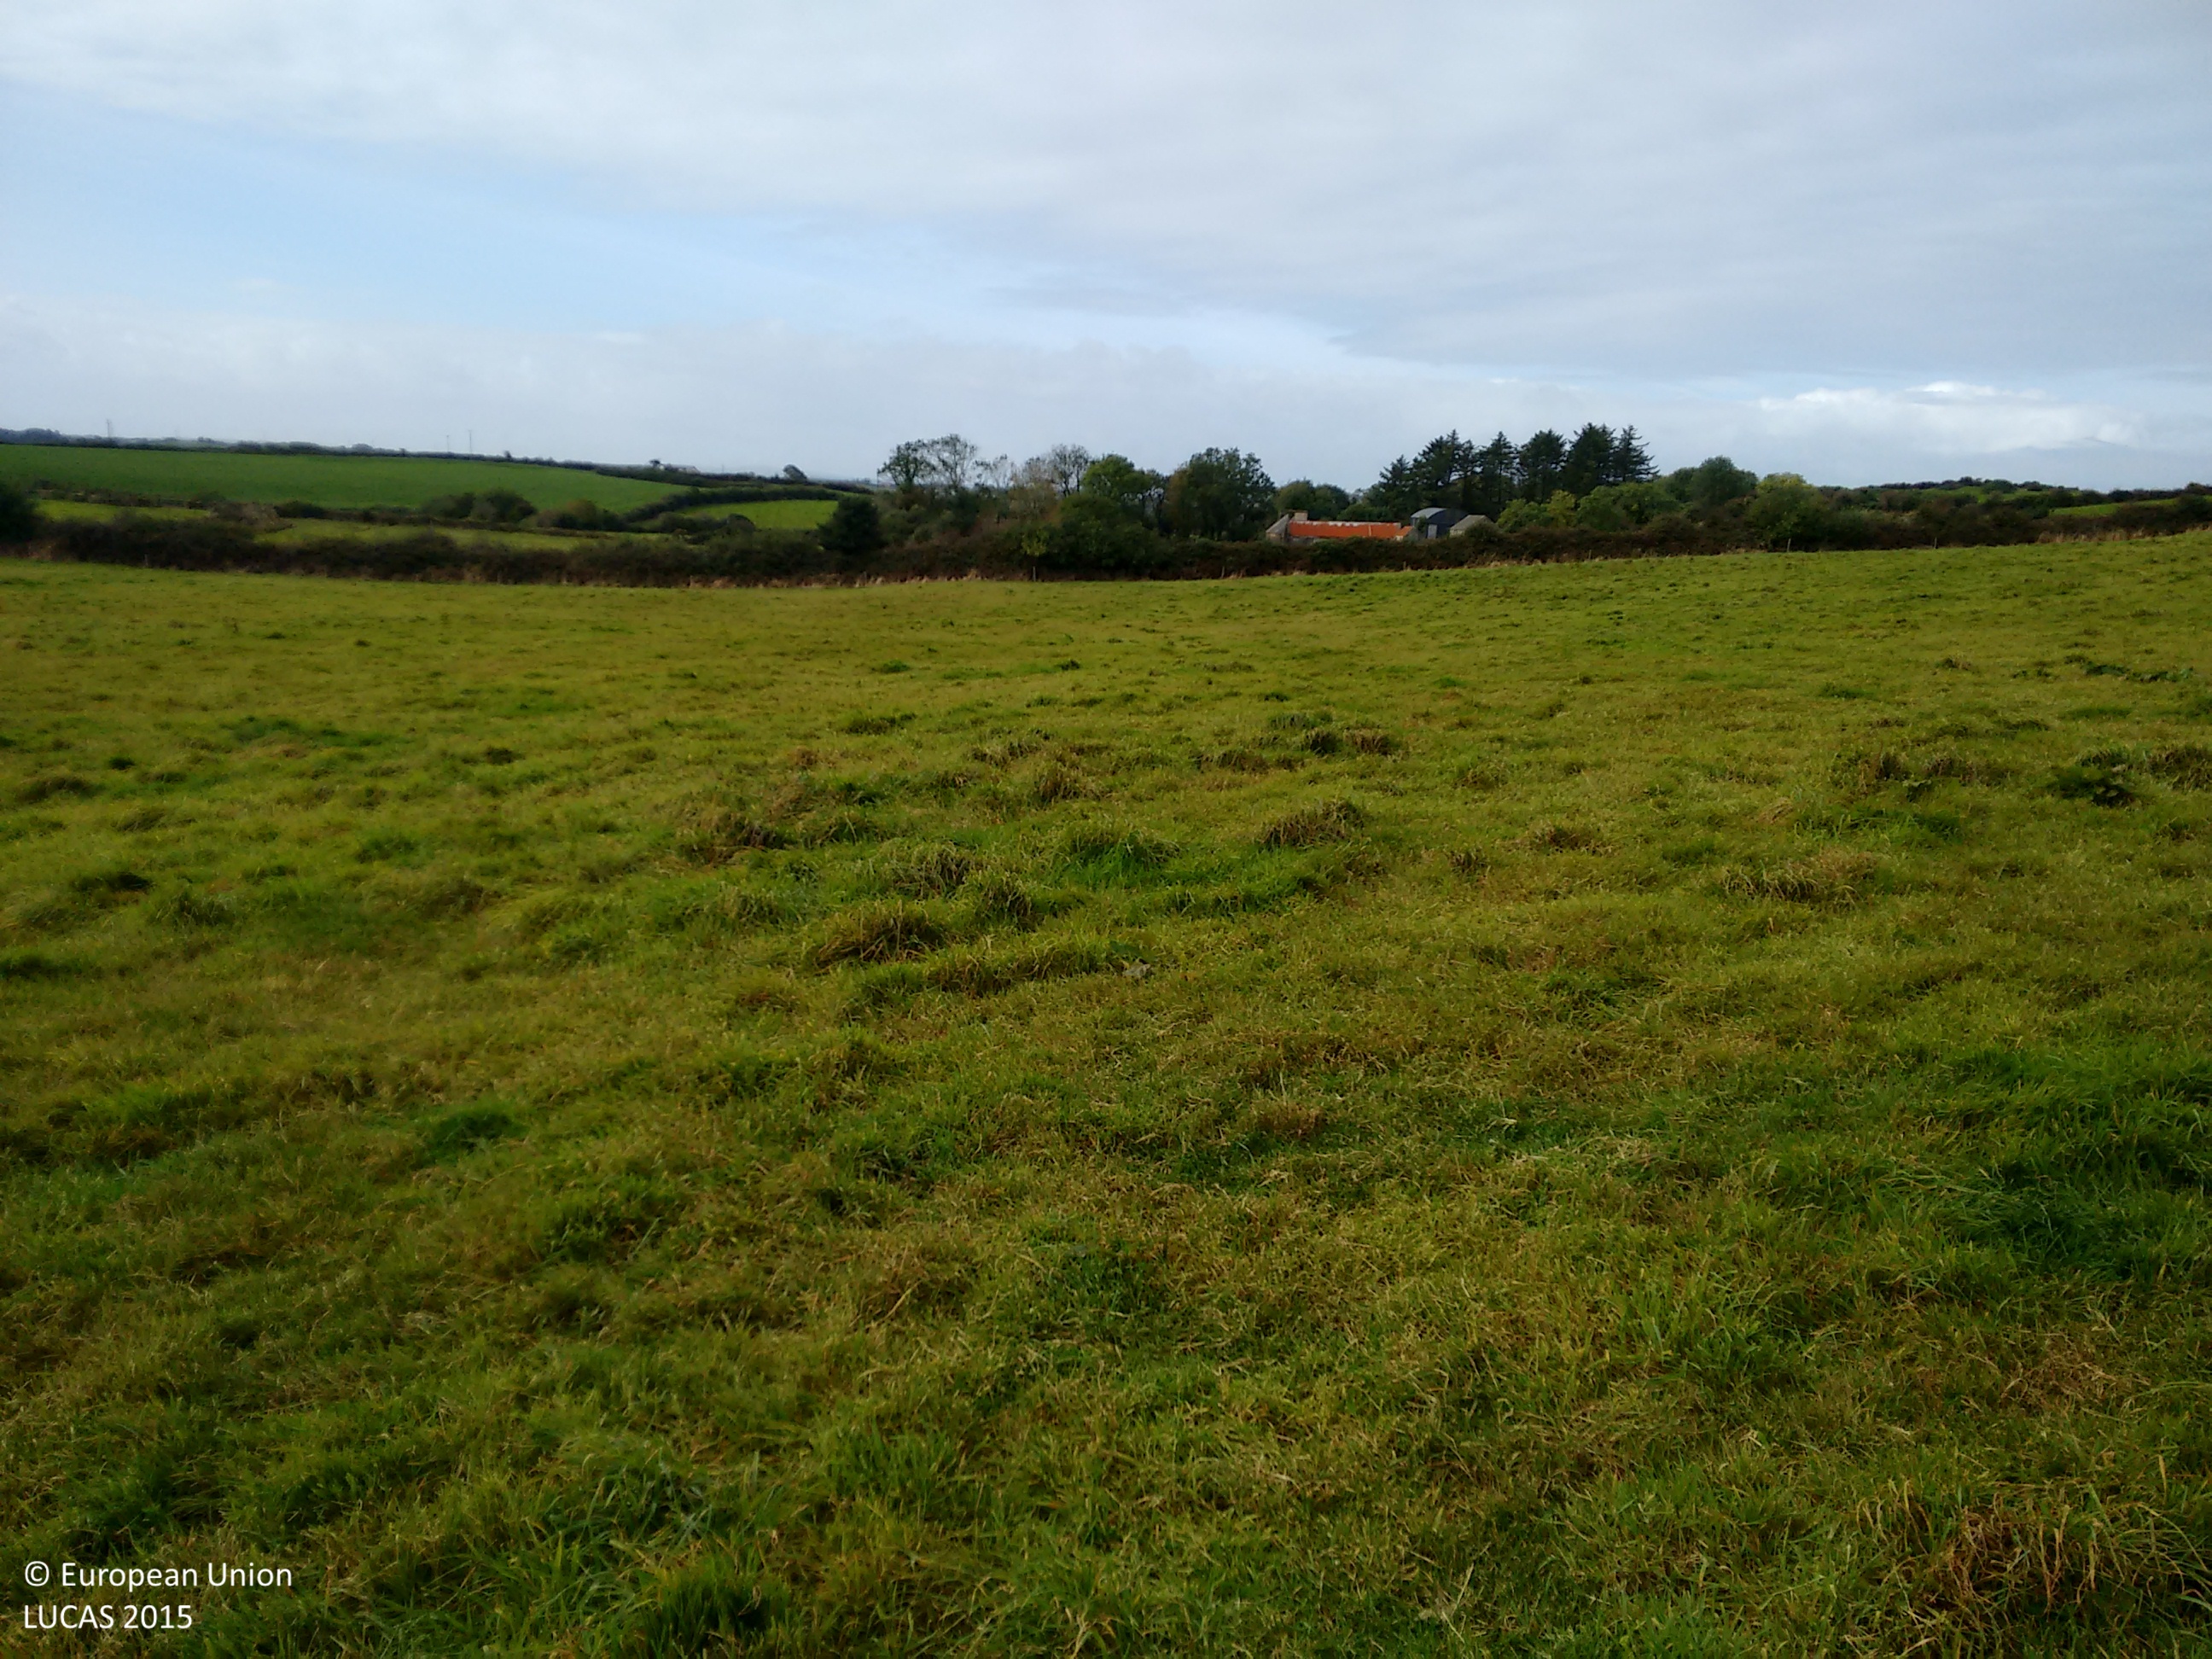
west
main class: Grassland
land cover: Grassland without tree/shrub cover
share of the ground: > 75 %
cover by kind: herbaceous plants 100 %
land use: Agriculture (excluding fallow land and kitchen gardens)
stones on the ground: < 10 %
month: September
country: IE
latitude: 52.7224
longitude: -9.3716
